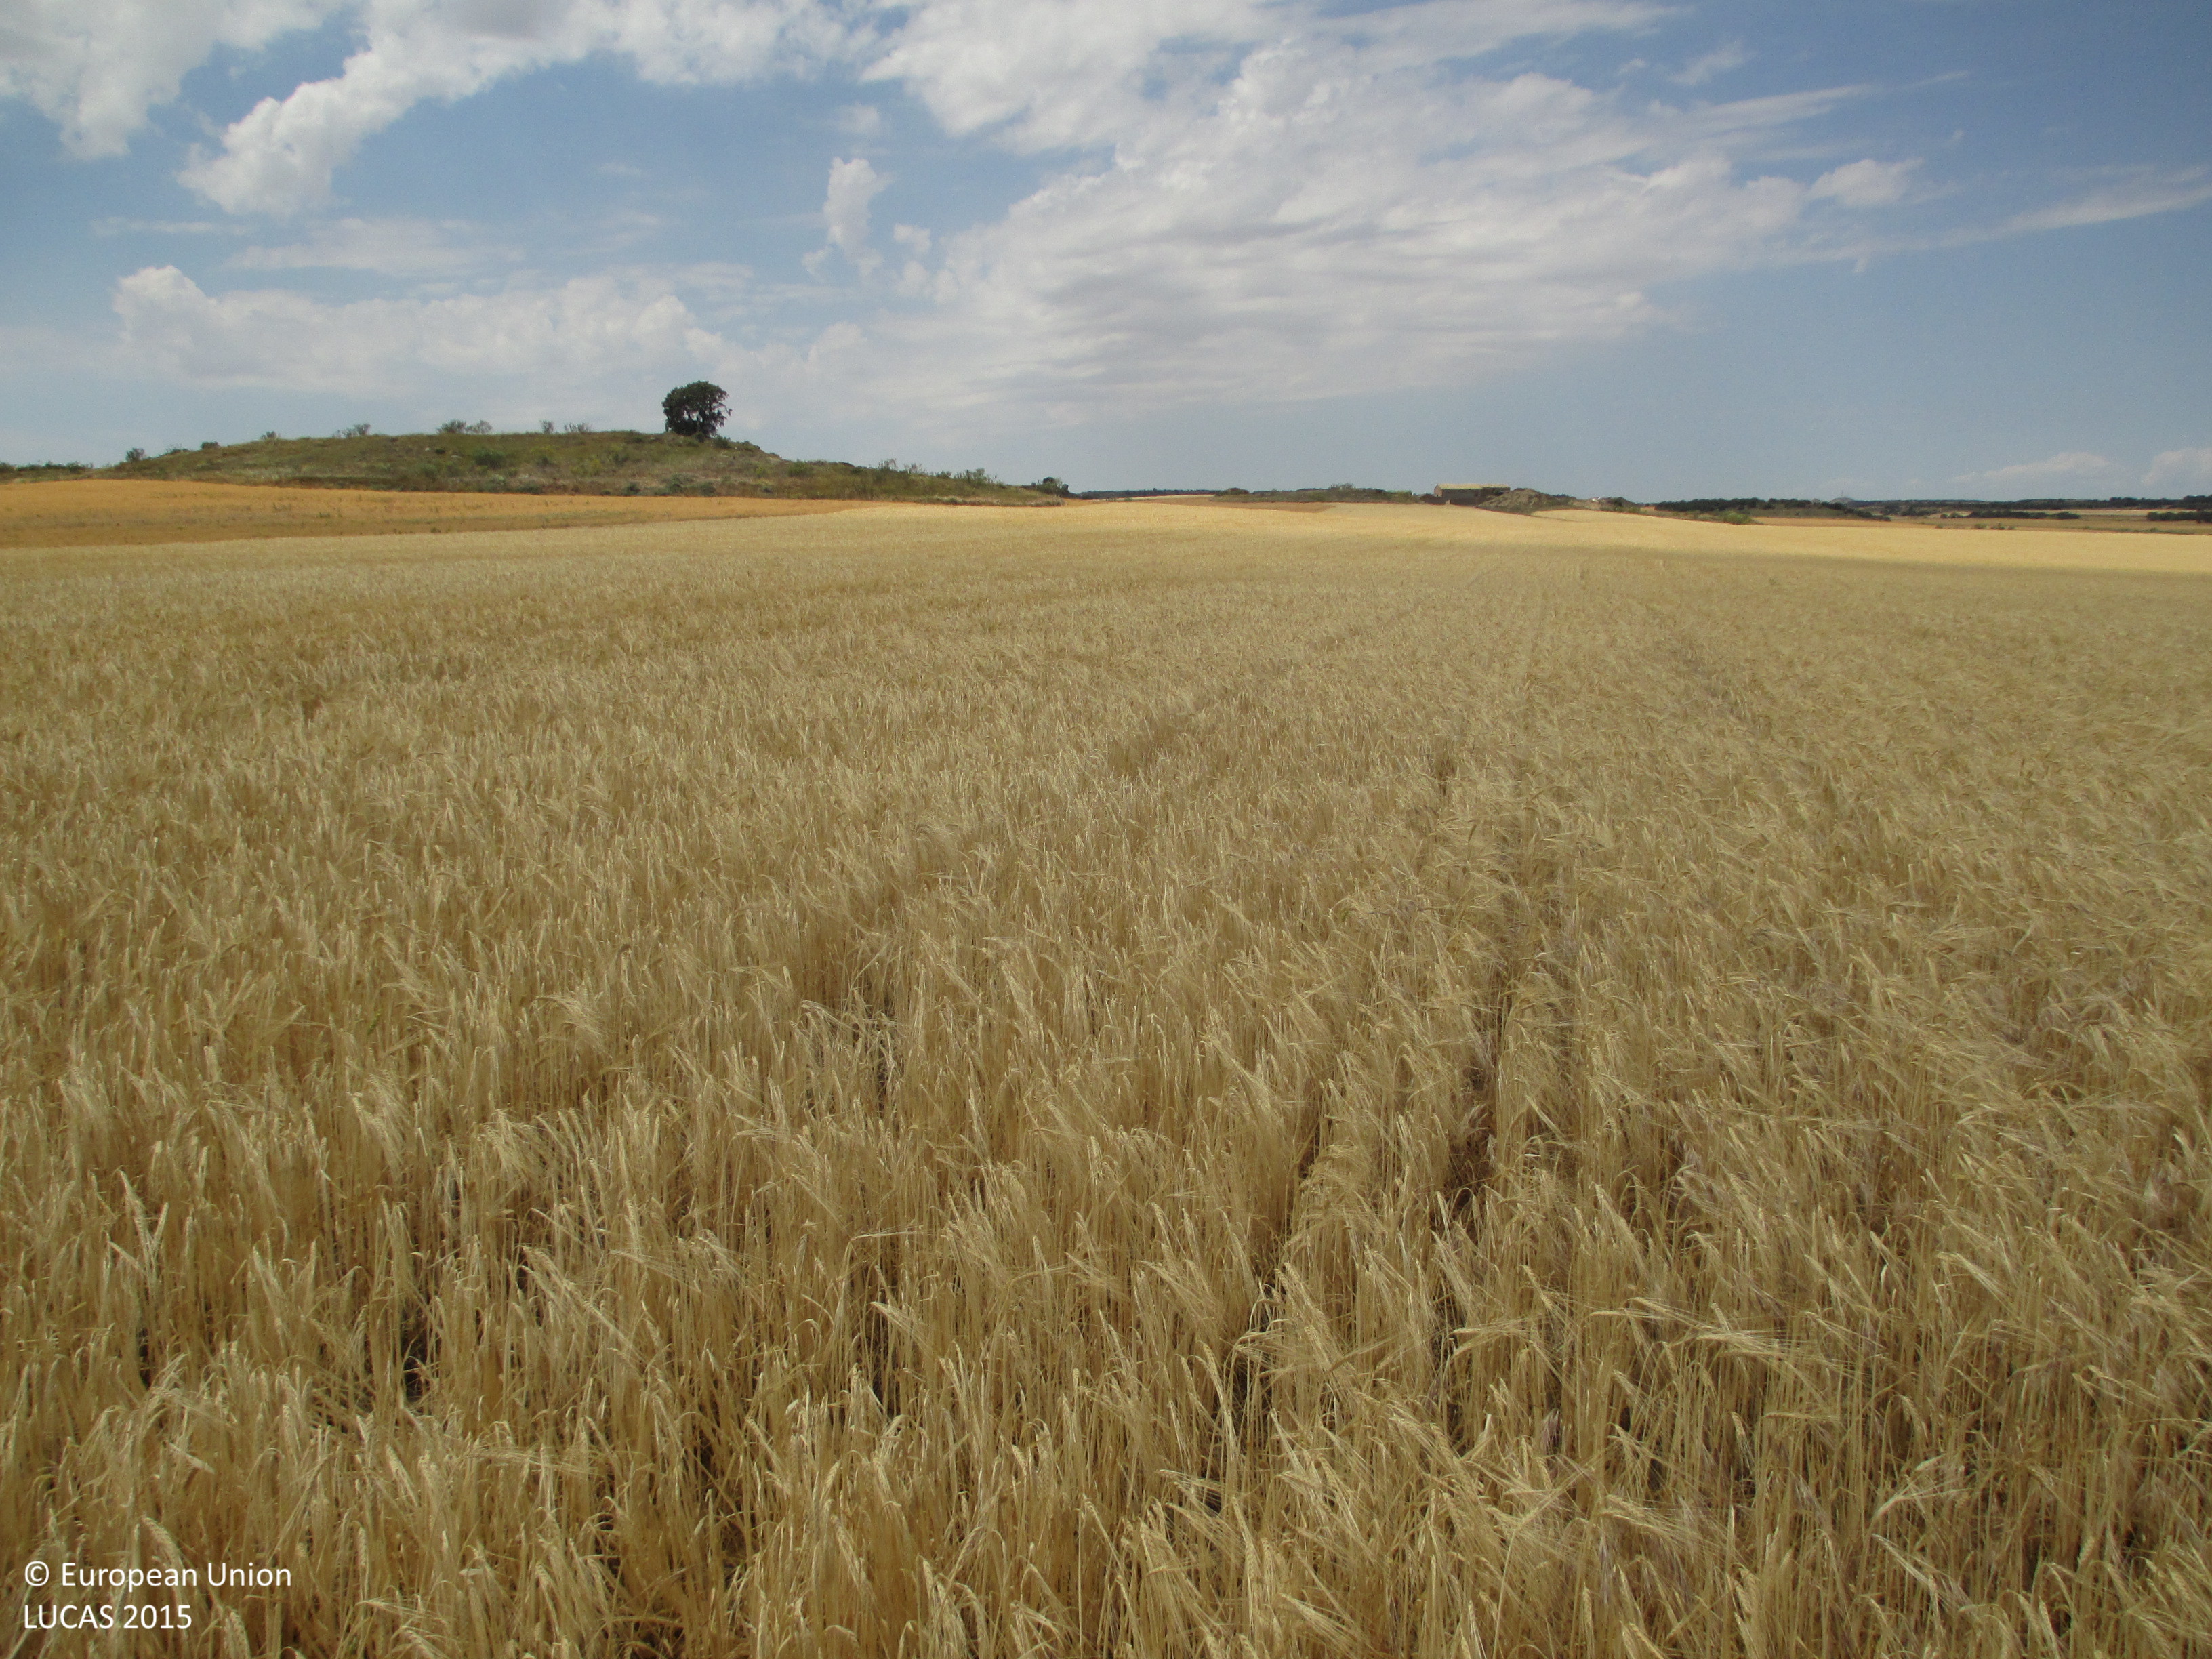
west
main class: Cropland
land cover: Barley
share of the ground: > 75 %
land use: Agriculture (excluding fallow land and kitchen gardens)
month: May
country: ES
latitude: 41.9545
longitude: -0.2139
